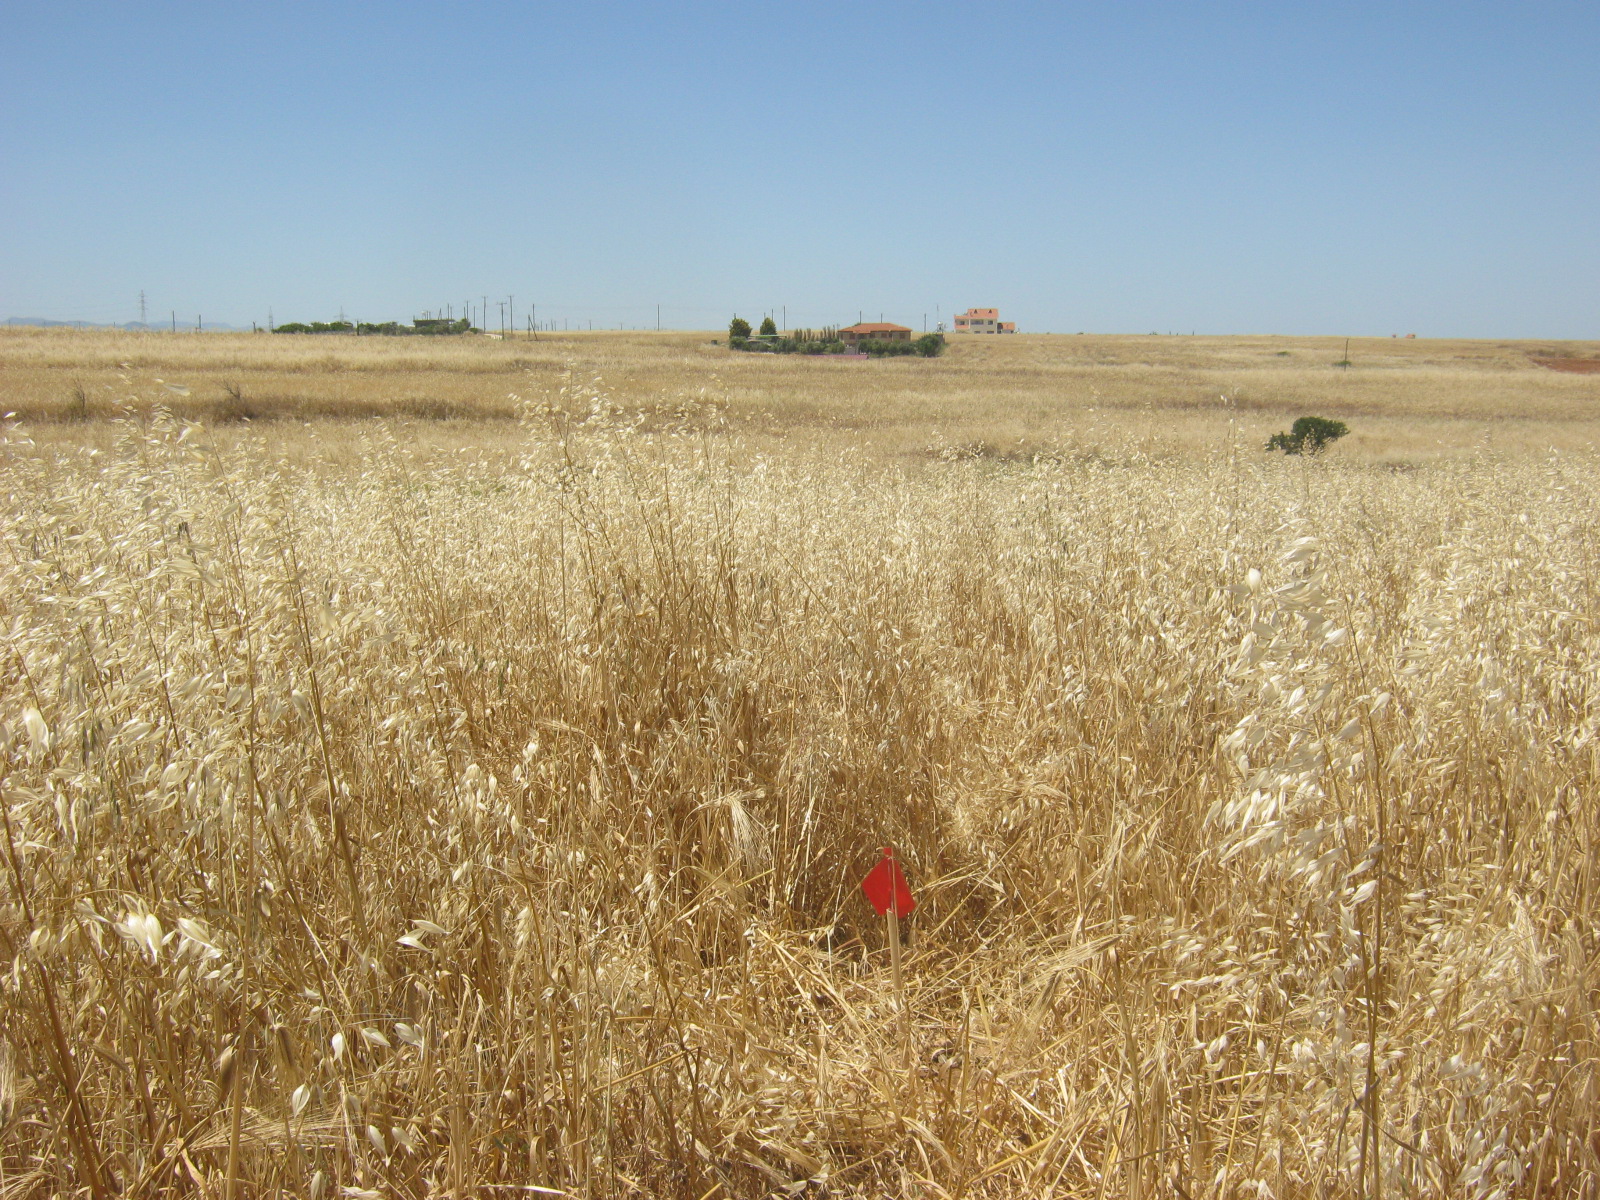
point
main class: Cropland
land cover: Barley
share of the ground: > 75 %
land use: Agriculture (excluding fallow land and kitchen gardens)
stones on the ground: 10 - 25 %
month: May
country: CY
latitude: 35.1082
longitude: 33.2374
